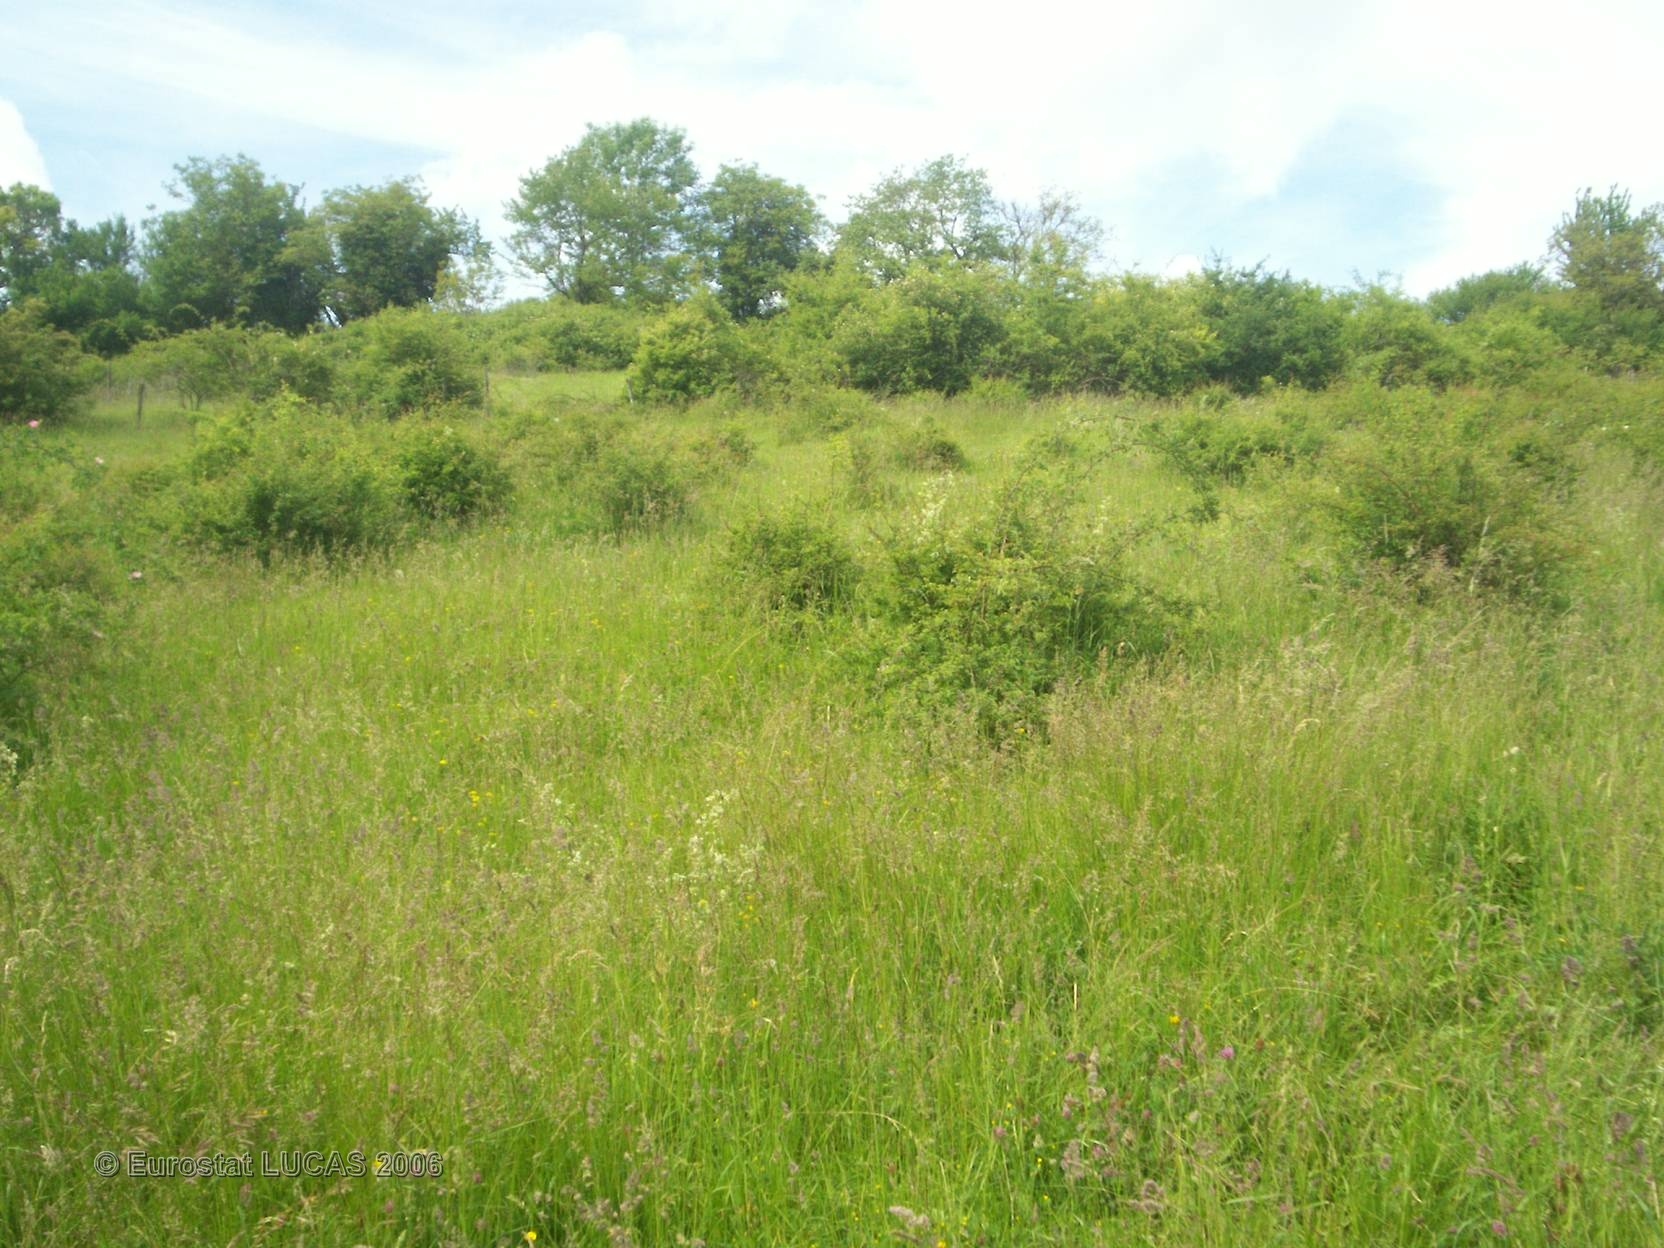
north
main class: Grassland
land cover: Grassland with sparse tree/shrub cover
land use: Agriculture (excluding fallow land and kitchen gardens)
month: May
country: FR
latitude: 46.1625
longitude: 3.0700
